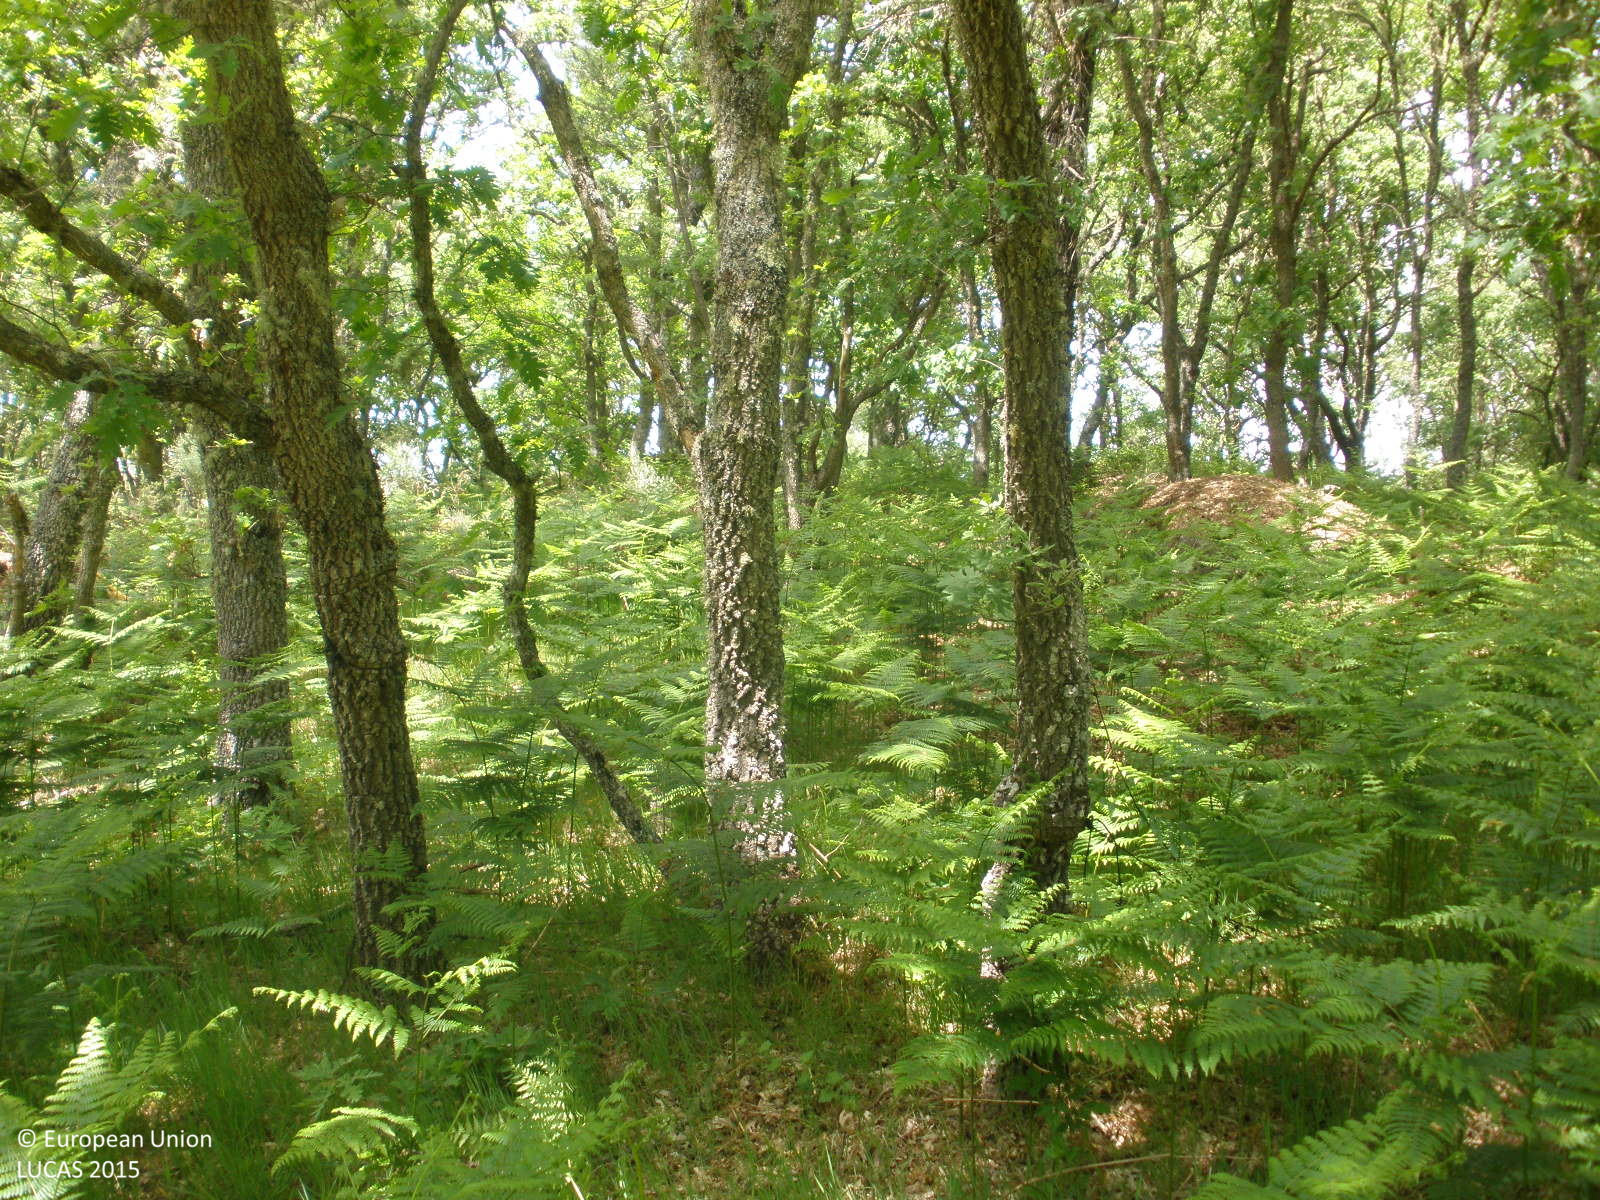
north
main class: Woodland
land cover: Broadleaved woodland
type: thermophilous deciduous forest
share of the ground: > 75 %
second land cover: Grassland without tree/shrub cover
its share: > 75 %
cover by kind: broadleaved forest trees 80 %, shrubs 10 %, herbaceous plants 10 %
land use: Forestry
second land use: Agriculture (excluding fallow land and kitchen gardens)
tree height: > 5 m
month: May
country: ES
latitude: 40.3084
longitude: -6.6429
